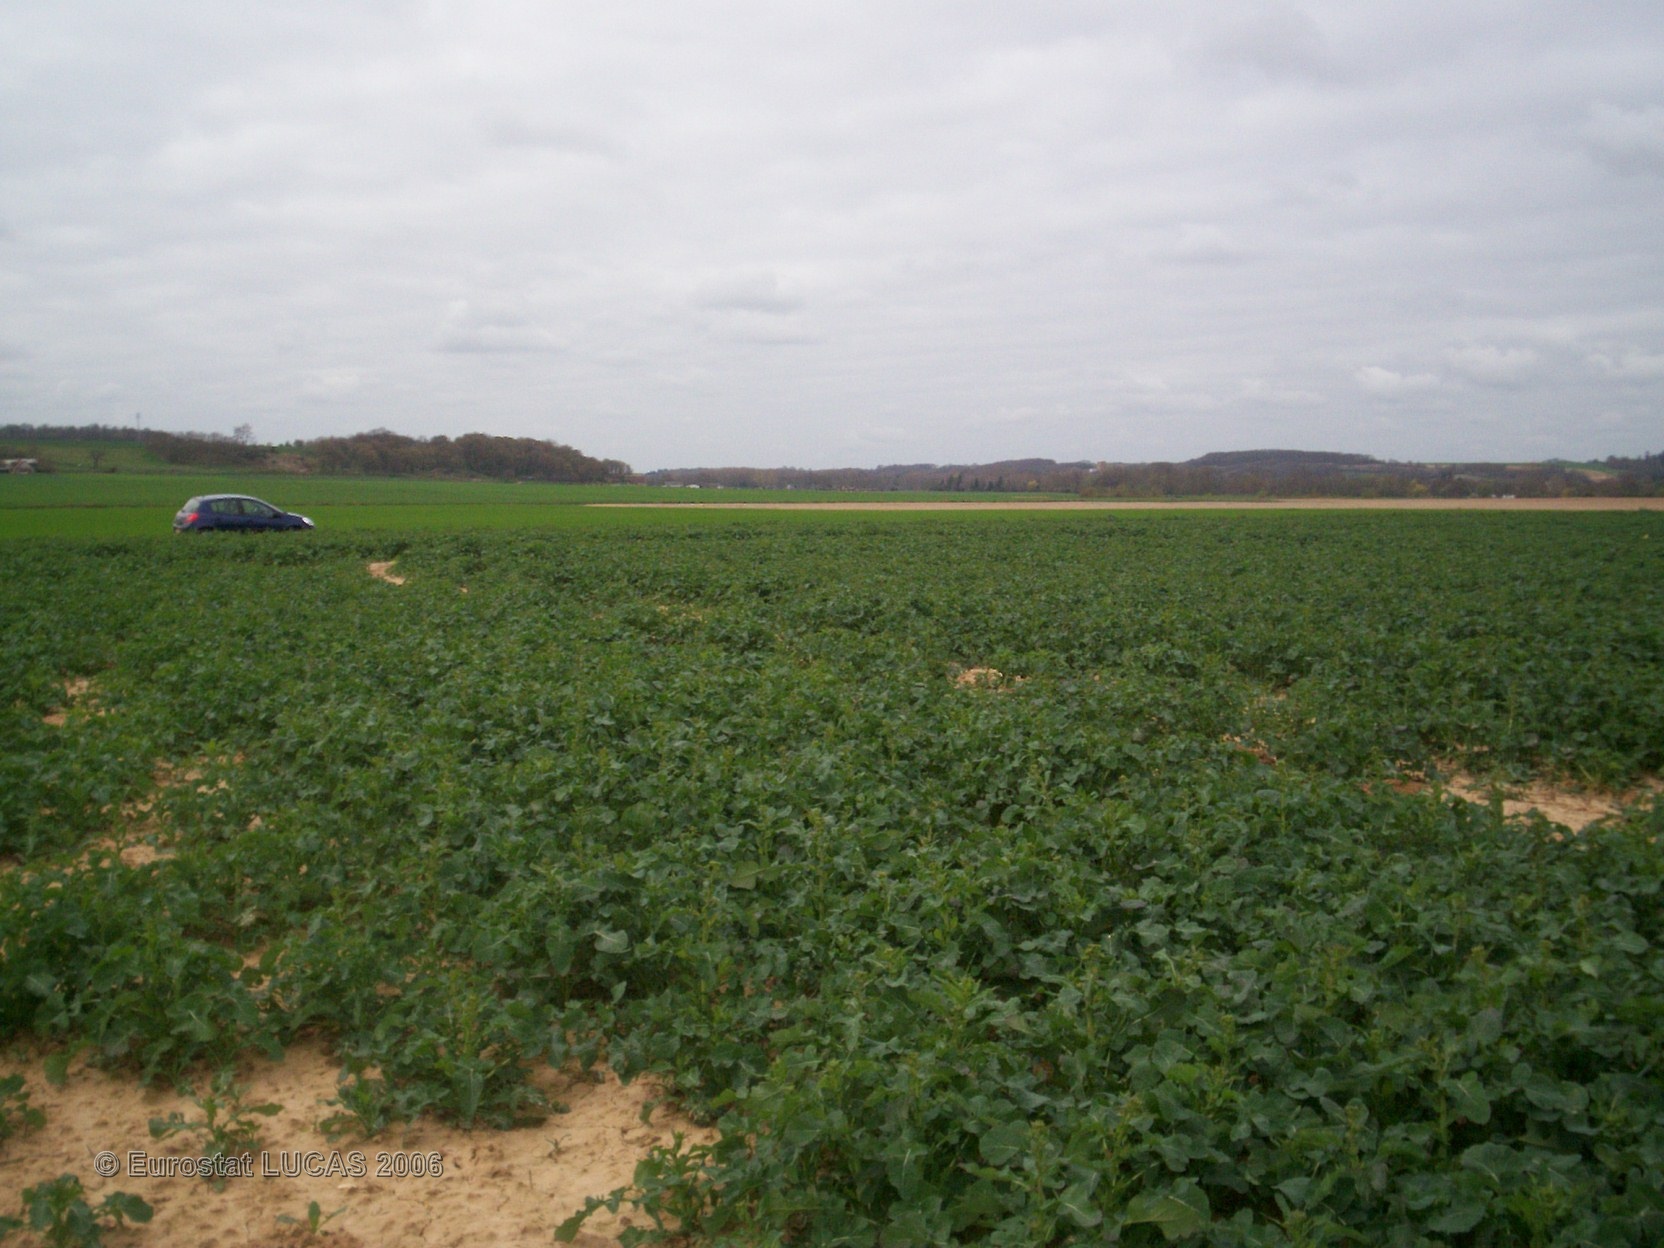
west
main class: Cropland
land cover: Rape and turnip rape
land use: Agriculture (excluding fallow land and kitchen gardens)
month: April
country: FR
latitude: 47.8689
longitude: 1.1725
